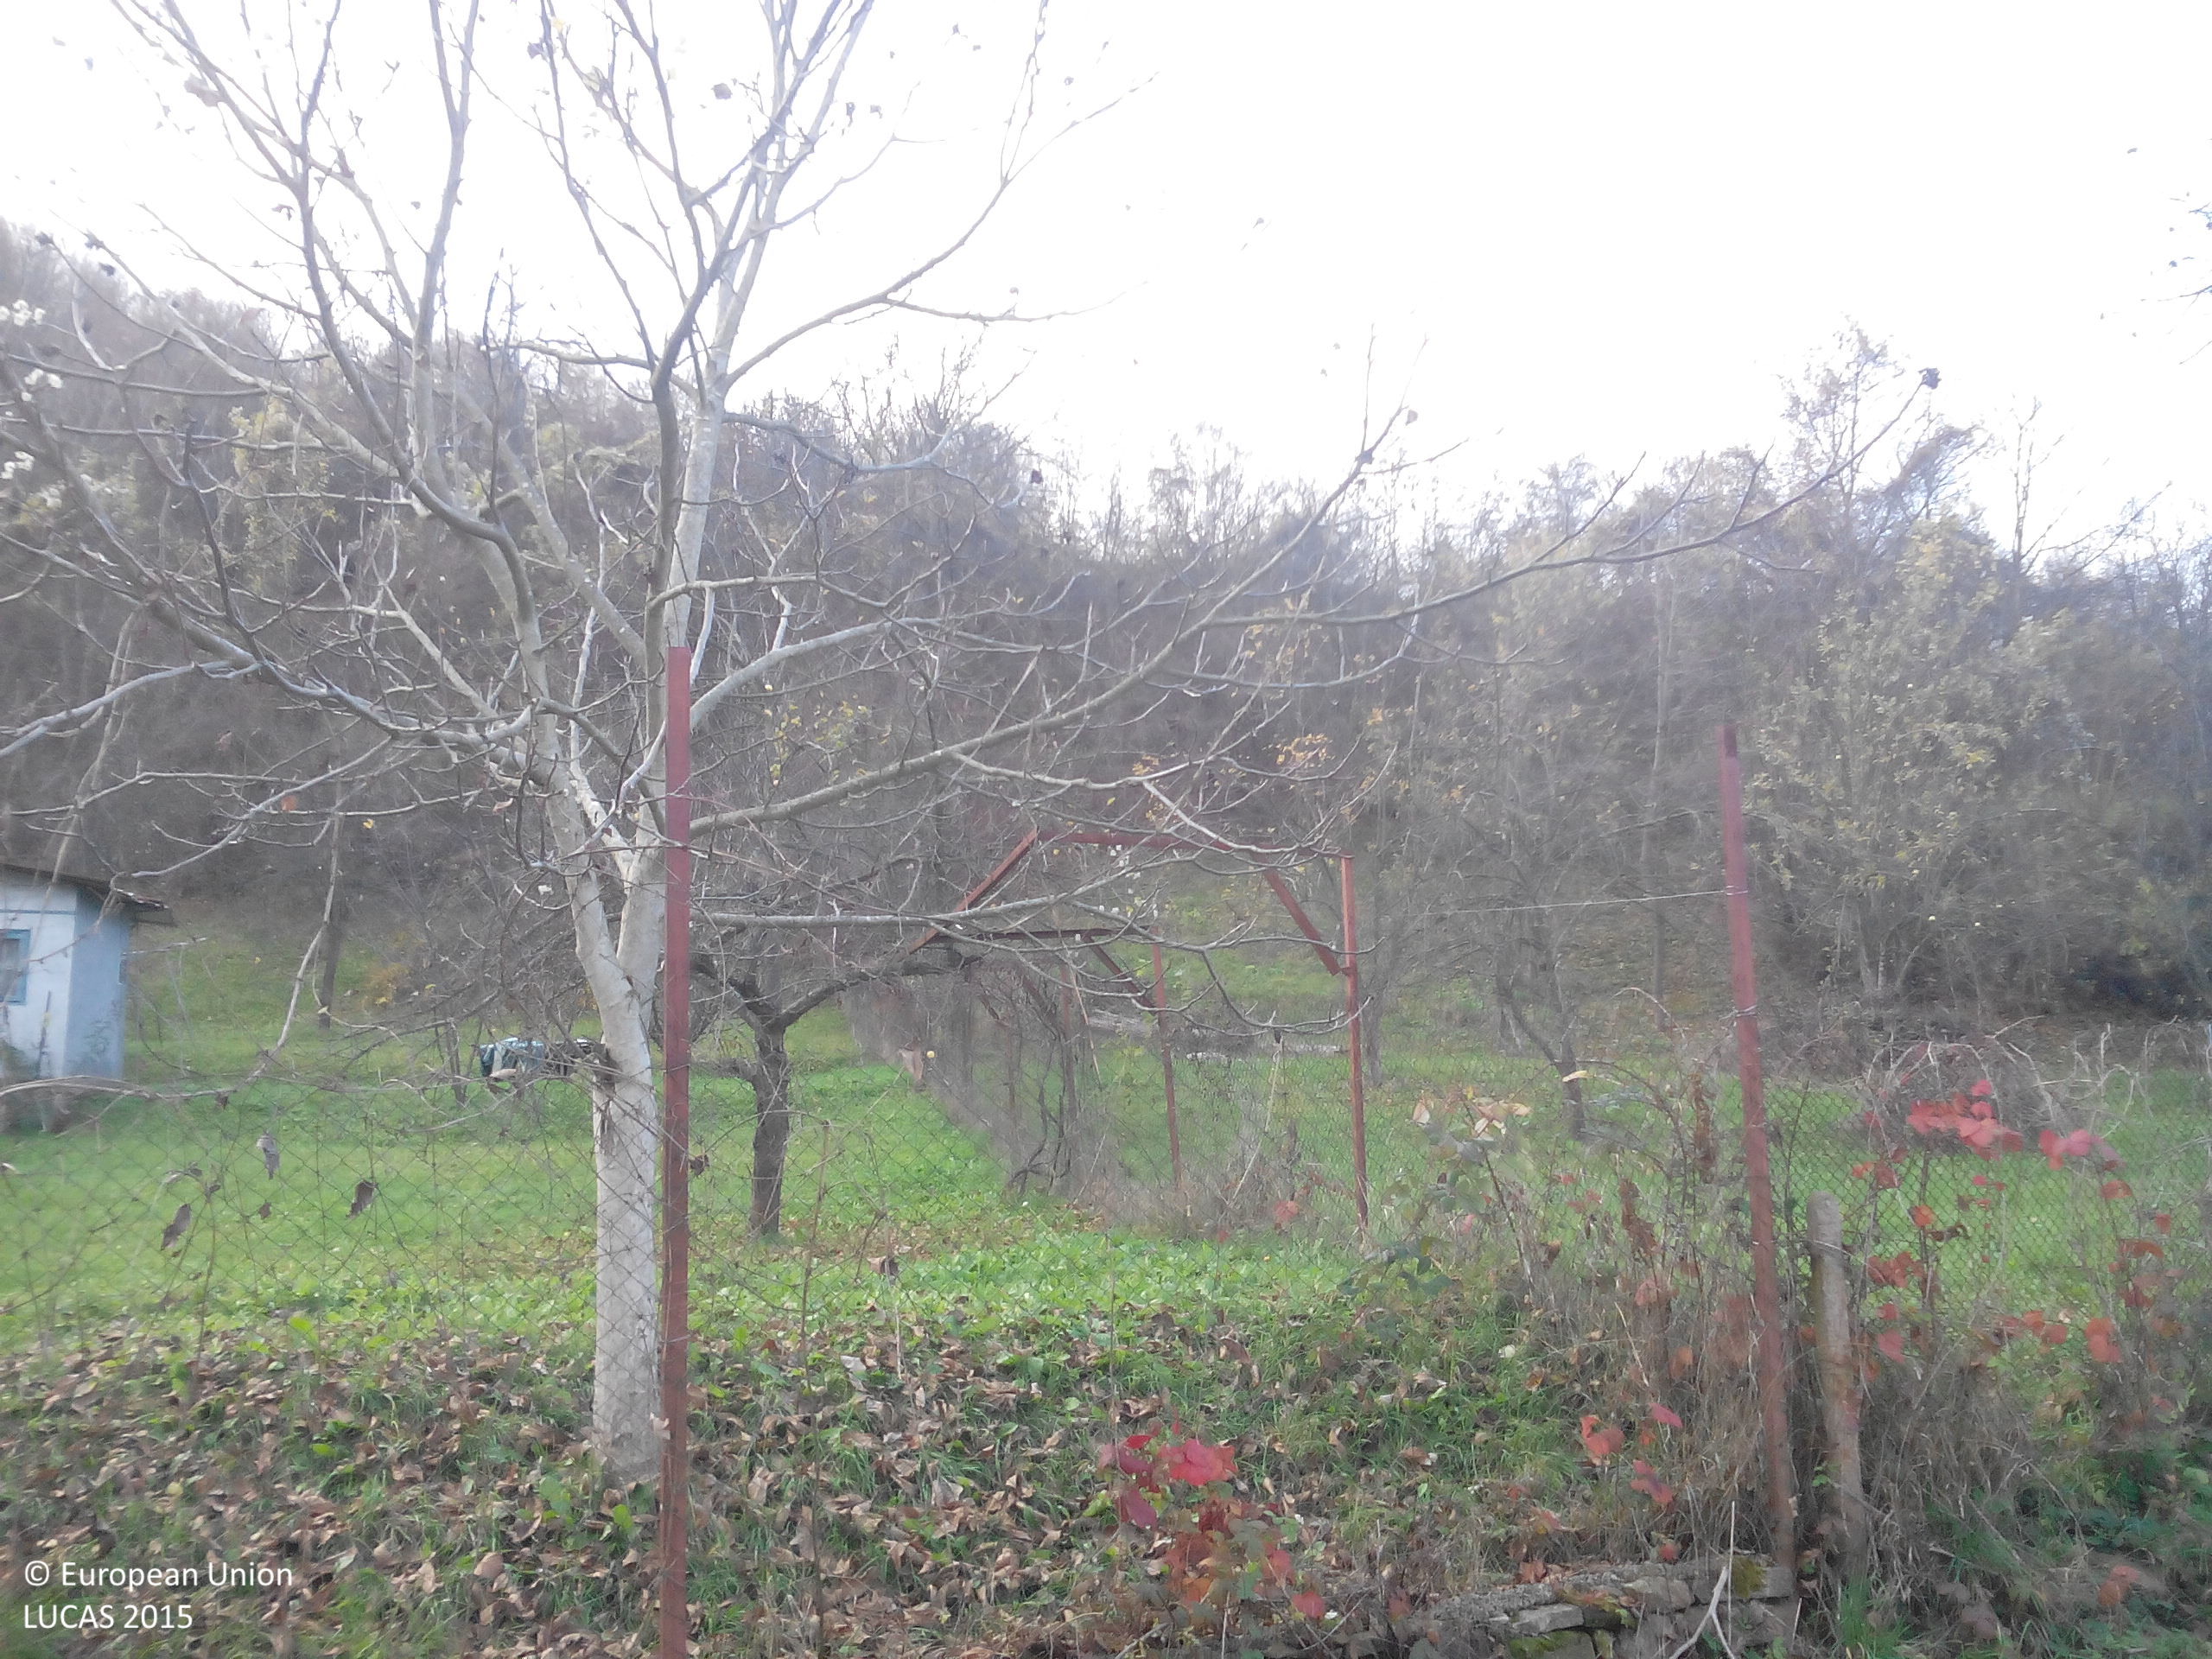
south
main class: Woodland
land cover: Broadleaved woodland
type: mesophytic deciduous forest
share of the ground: > 75 %
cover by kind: broadleaved forest trees 85 %, herbaceous plants 10 %, shrubs 5 %
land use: Residential
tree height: > 5 m
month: November
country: BG
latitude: 43.0277
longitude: 23.7522
